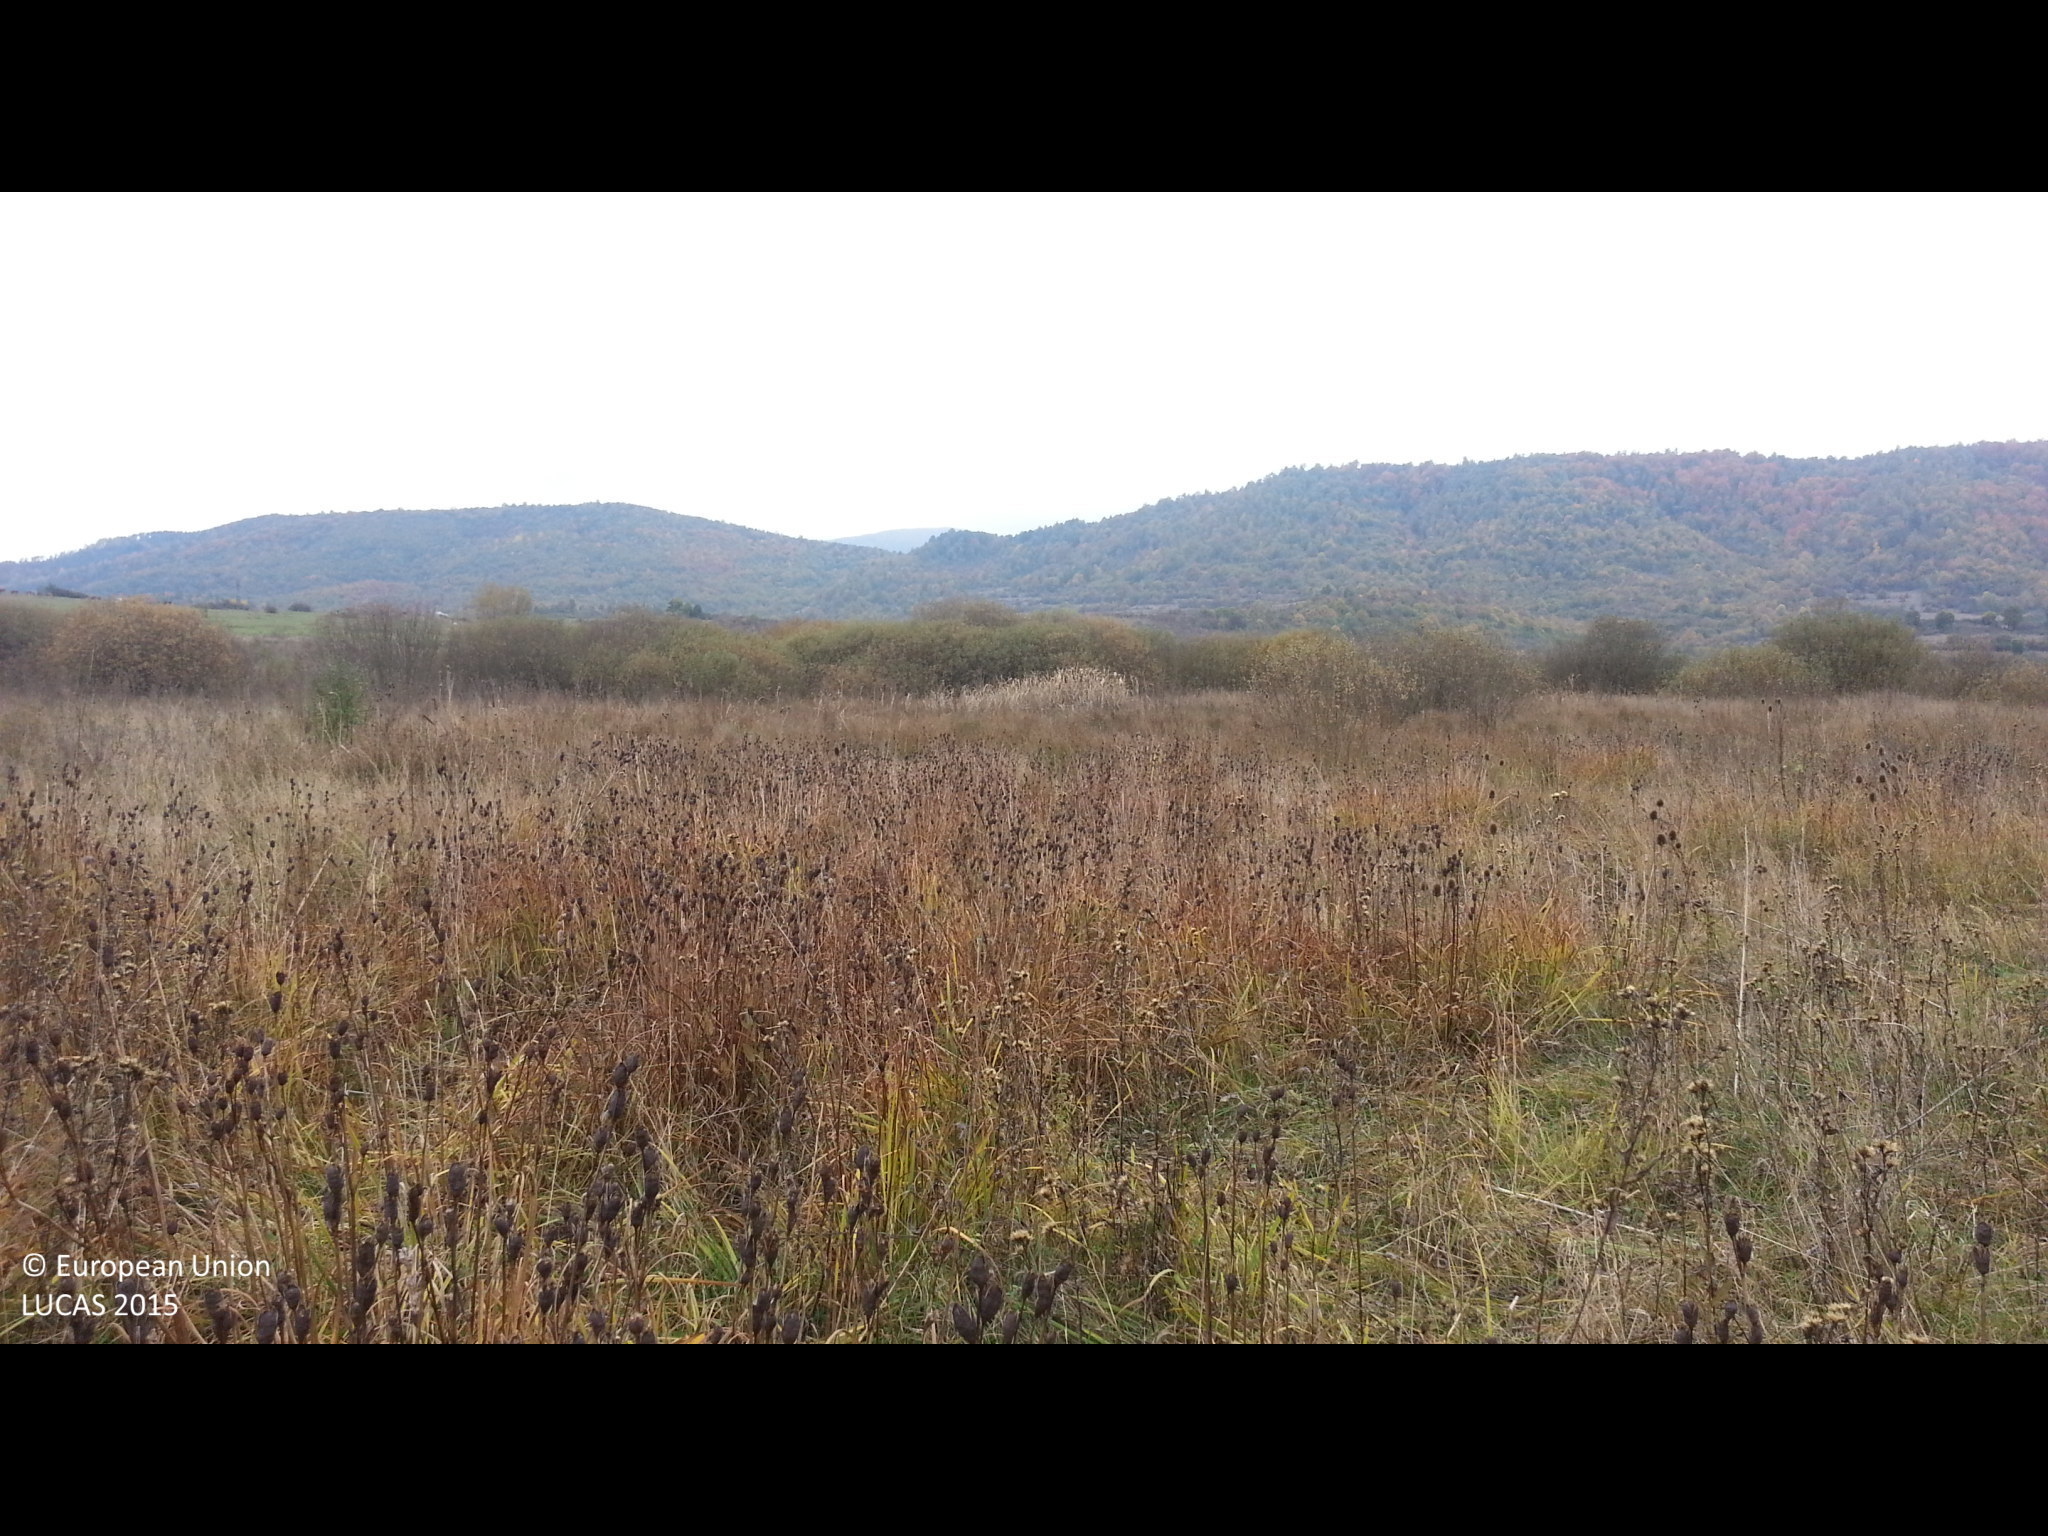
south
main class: Grassland
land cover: Grassland without tree/shrub cover
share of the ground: > 75 %
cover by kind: herbaceous plants 100 %
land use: Agriculture (excluding fallow land and kitchen gardens)
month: October
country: BG
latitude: 42.9215
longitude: 23.7272
